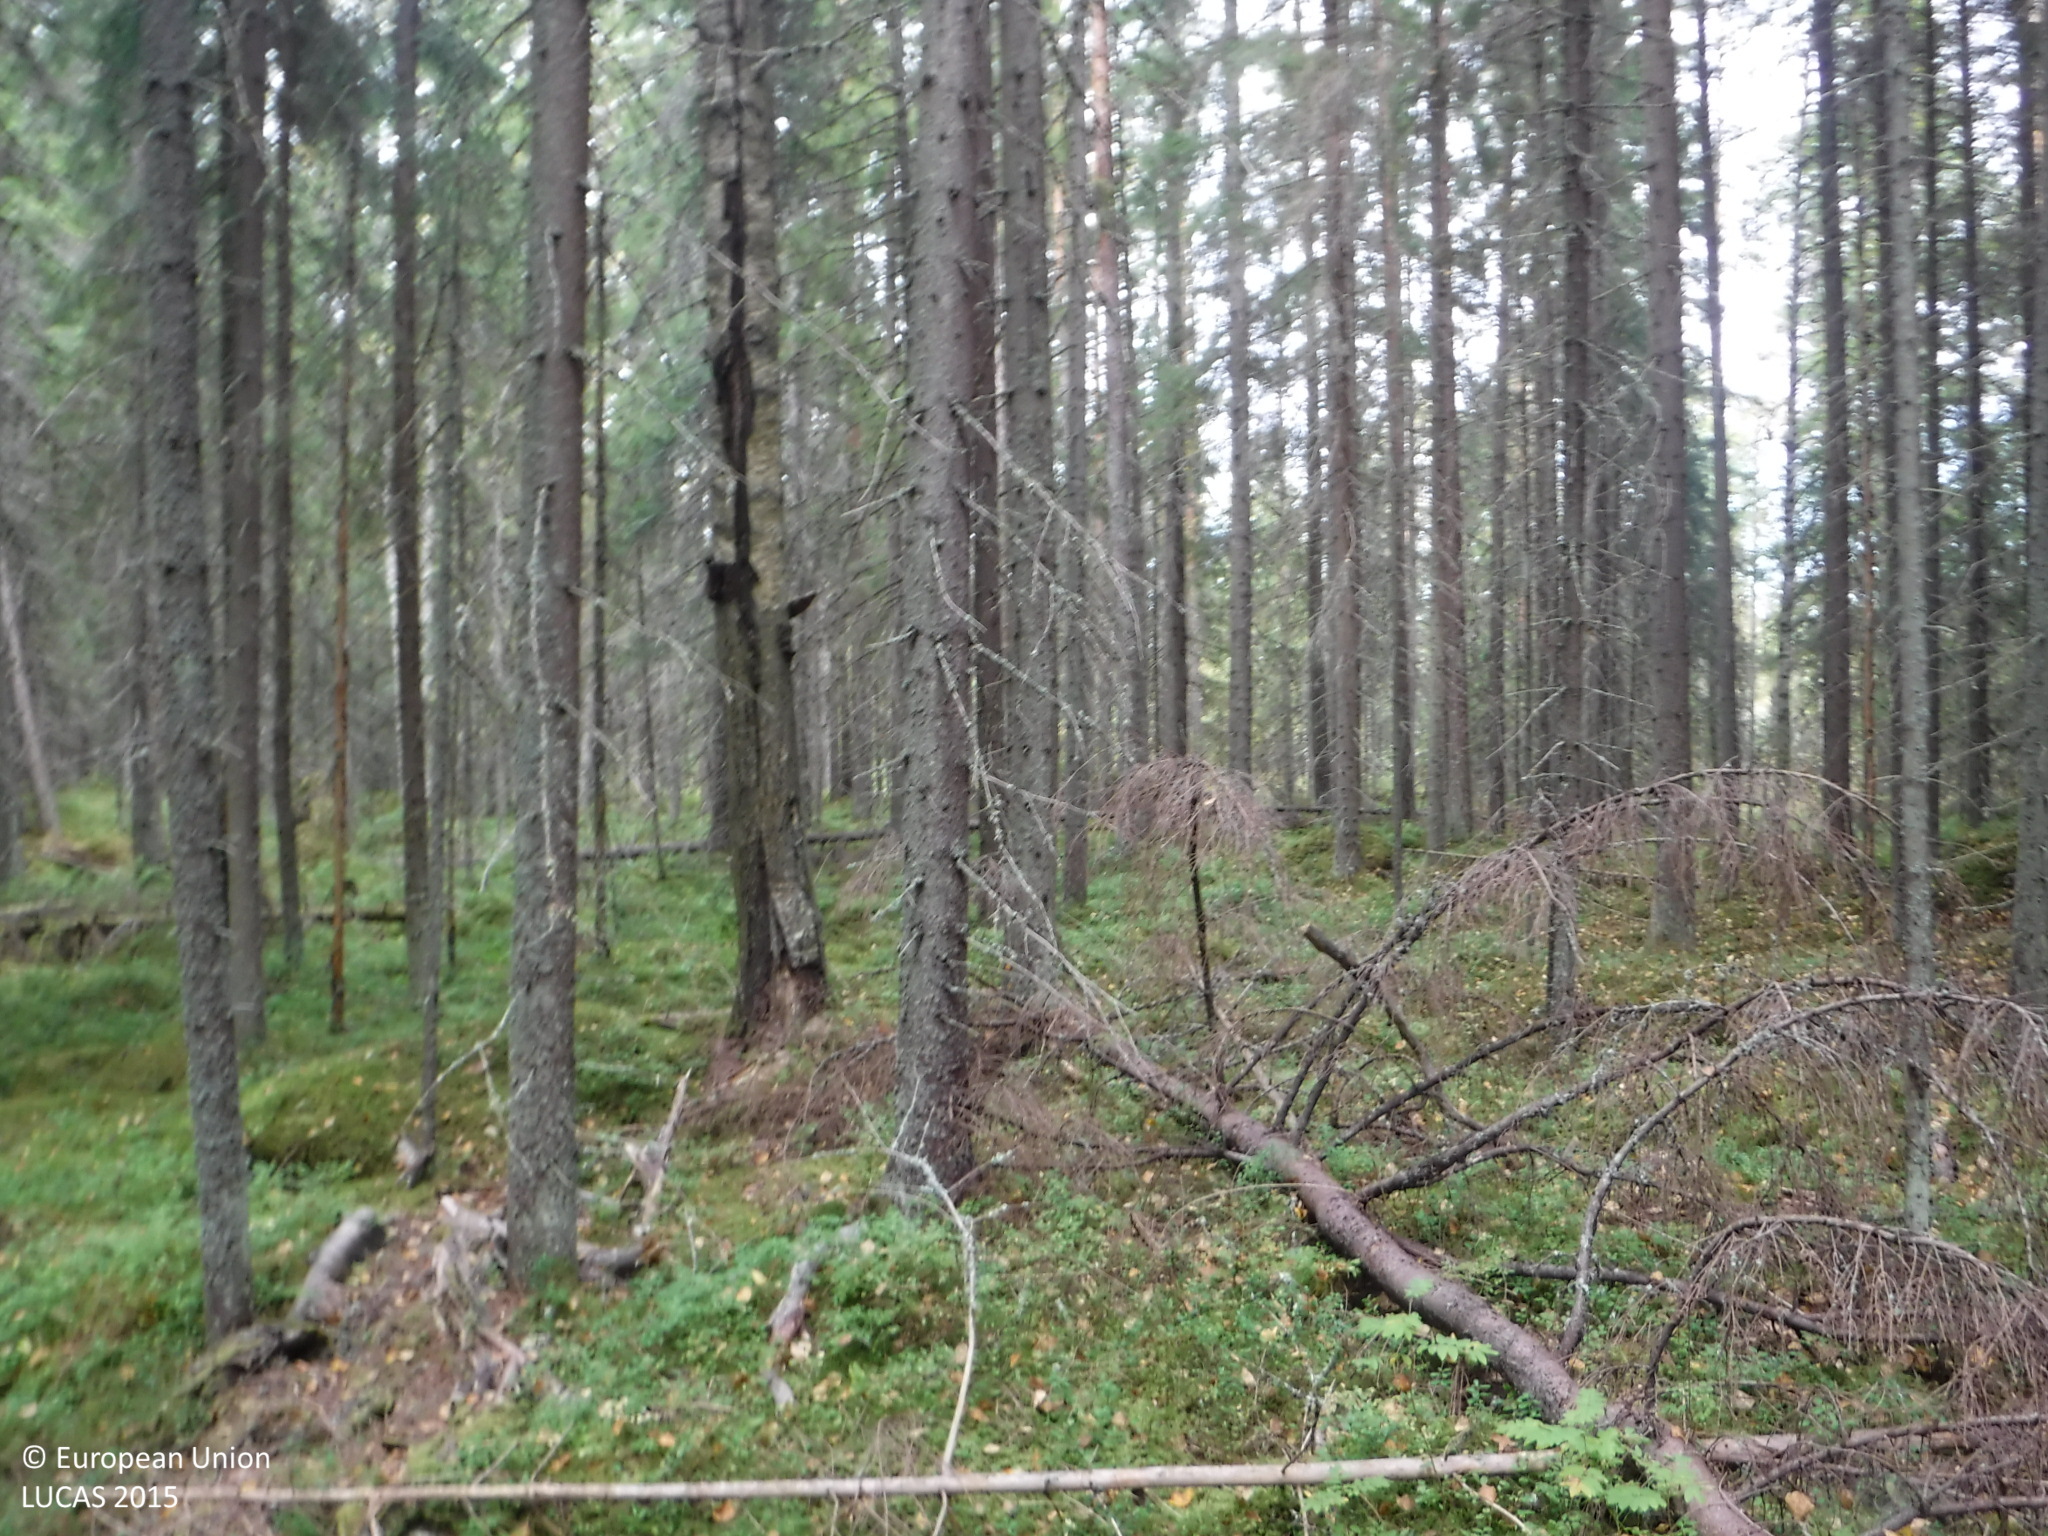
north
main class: Woodland
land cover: Spruce dominated coniferous woodland
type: boreal forest
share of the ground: 50 - 75 %
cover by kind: coniferous forest trees 65 %, lichens and mosses 25 %, shrubs 10 %
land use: Forestry
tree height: > 5 m
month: September
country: FI
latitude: 61.7404
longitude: 22.0783
